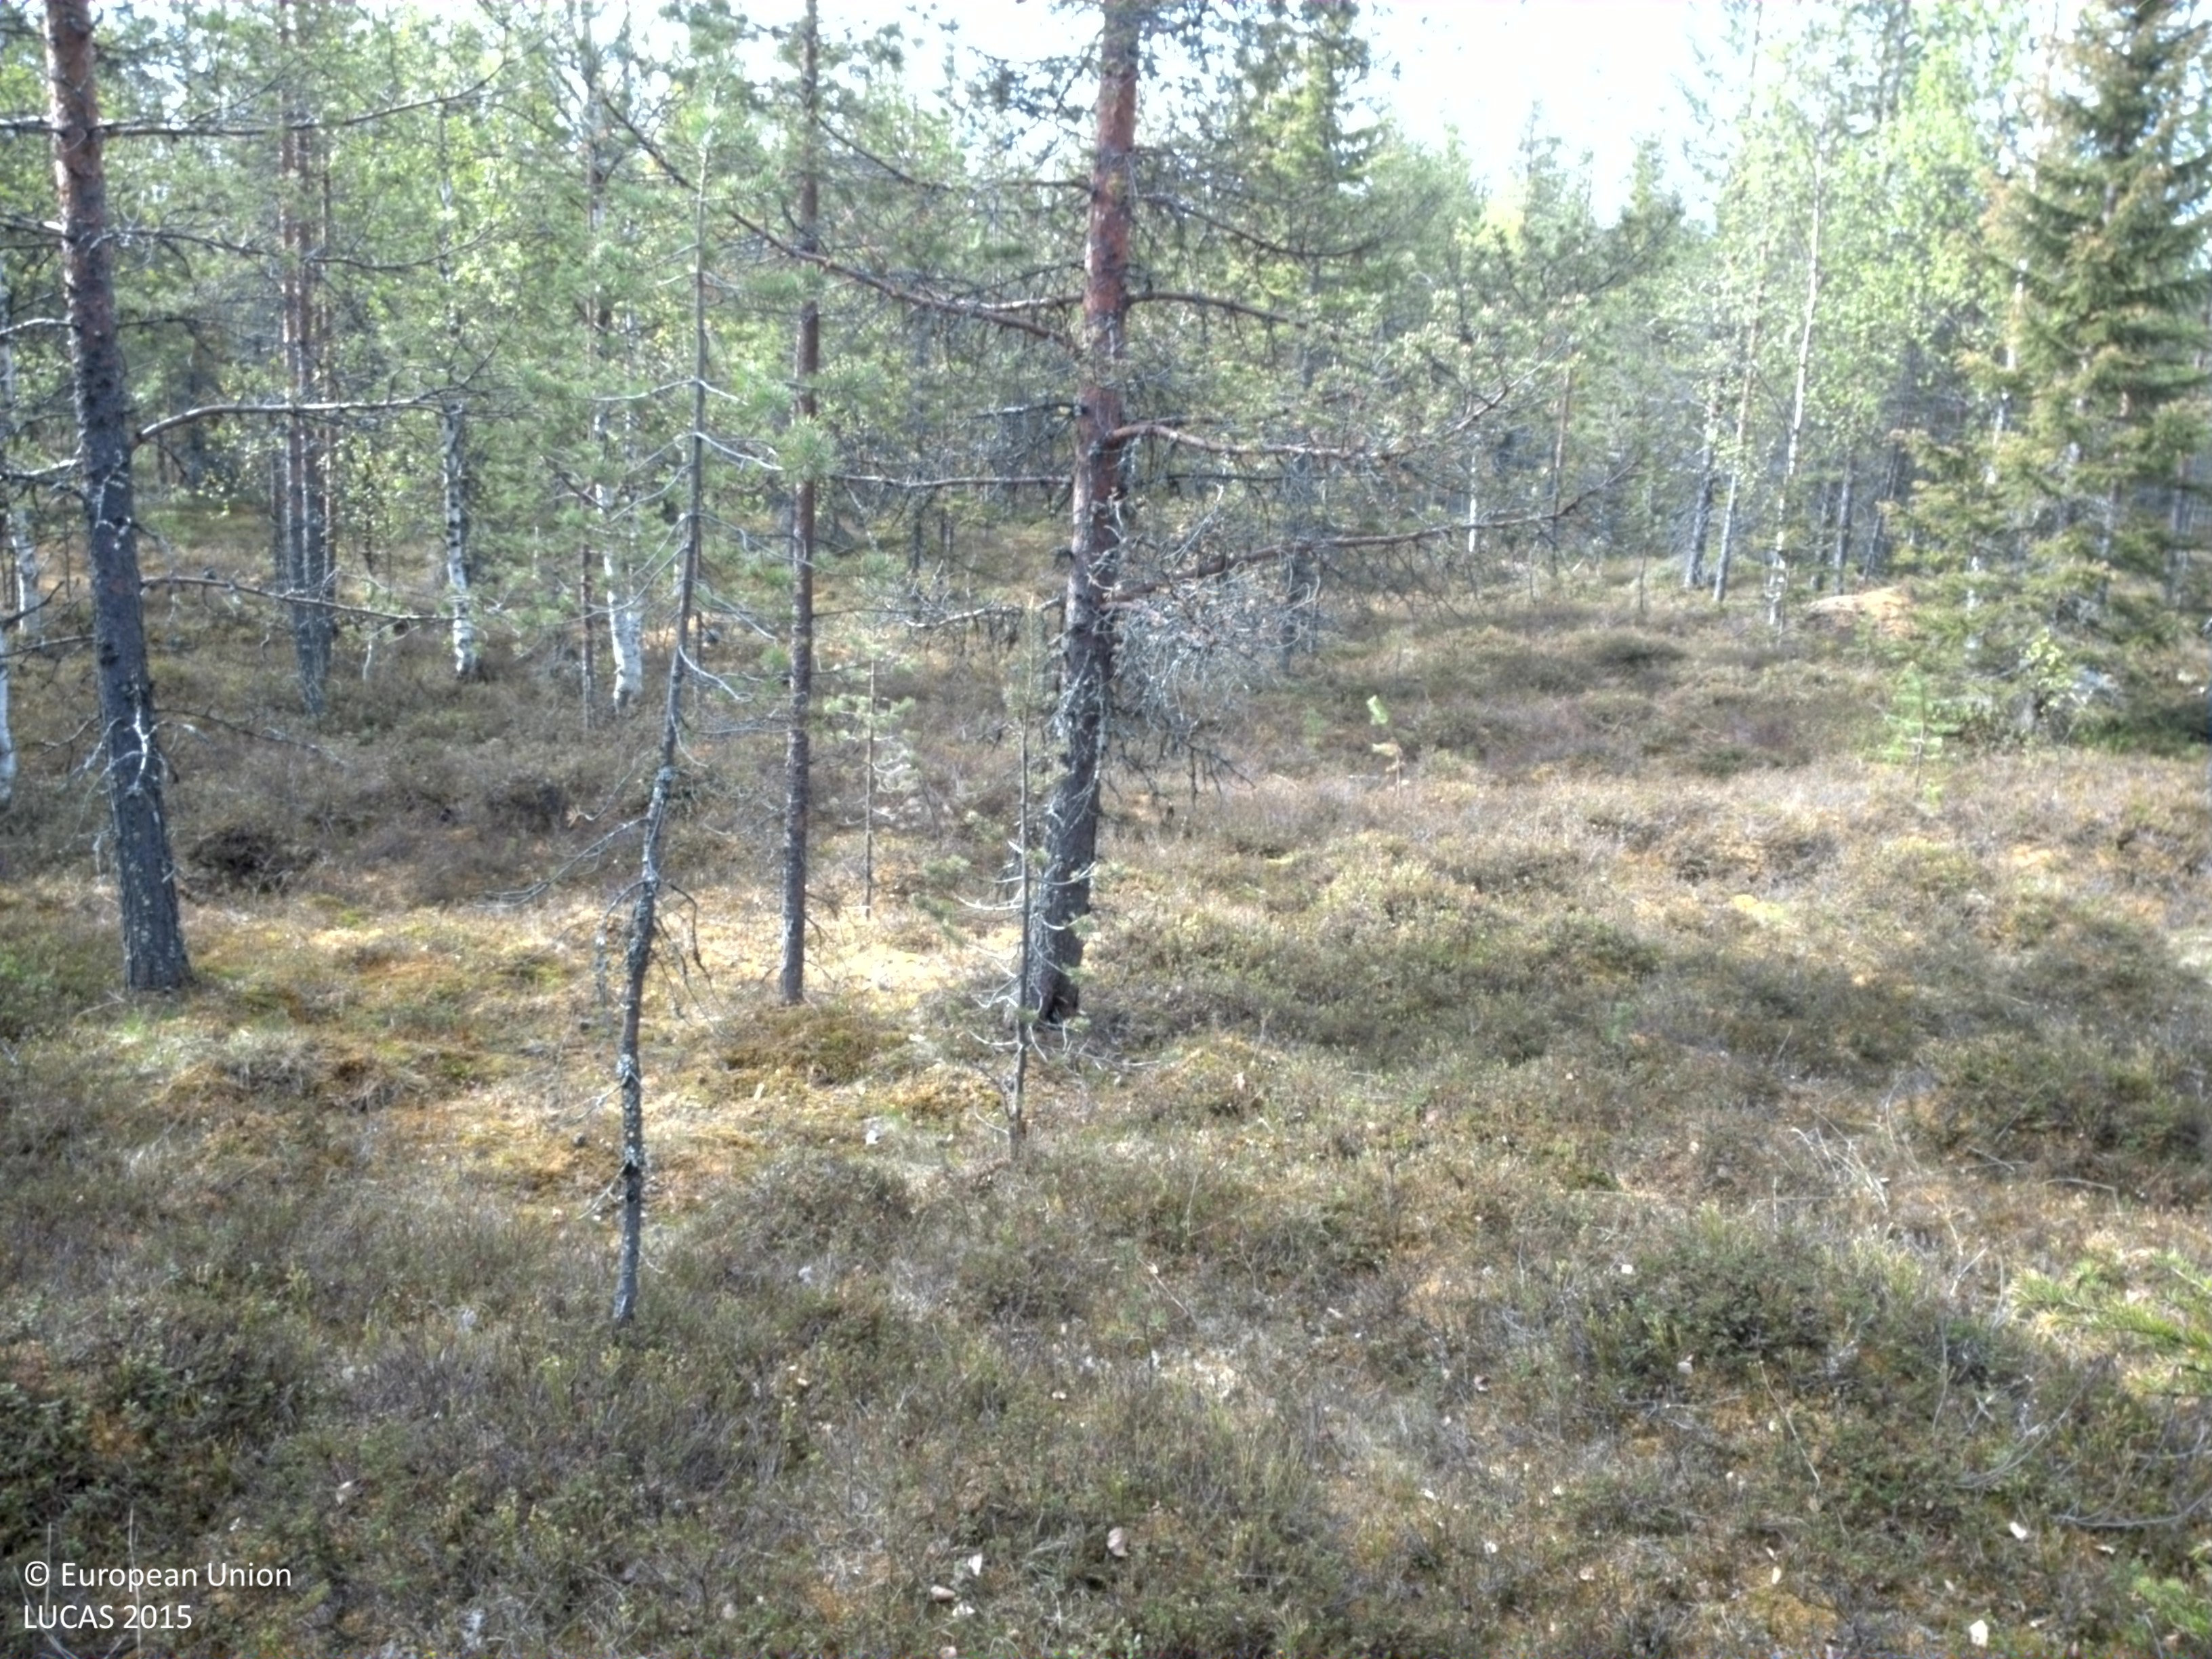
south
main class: Woodland
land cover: Pine dominated coniferous woodland
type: boreal forest
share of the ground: 25 - 50 %
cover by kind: shrubs 50 %, coniferous forest trees 45 %, broadleaved forest trees 5 %
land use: Forestry
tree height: > 5 m
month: June
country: SE
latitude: 65.8149
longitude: 19.6944
